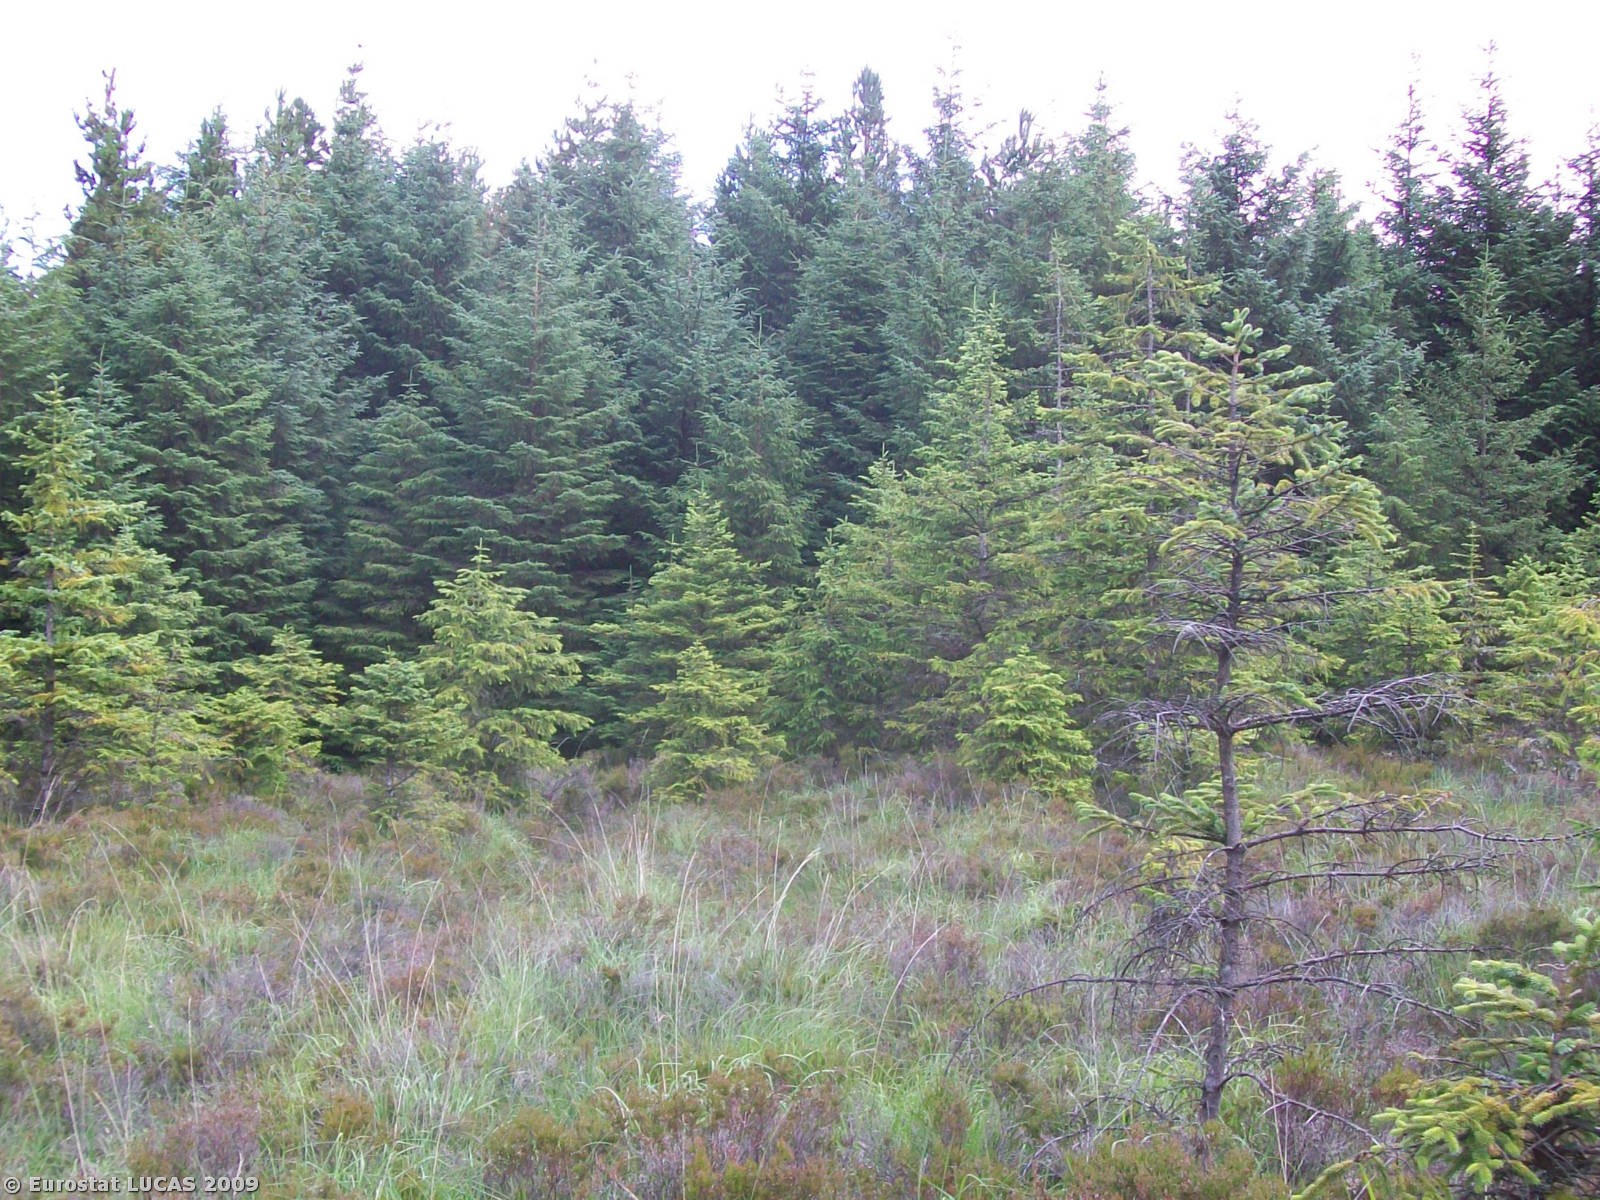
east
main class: Woodland
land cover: Coniferous woodland
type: plantations and self-sown exotic forest
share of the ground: > 75 %
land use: Forestry
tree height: > 5 m
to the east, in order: Coniferous woodland; Fences; Peatbogs; Electric lines; Peatbogs
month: July
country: IE
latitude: 54.0942
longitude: -8.9077
